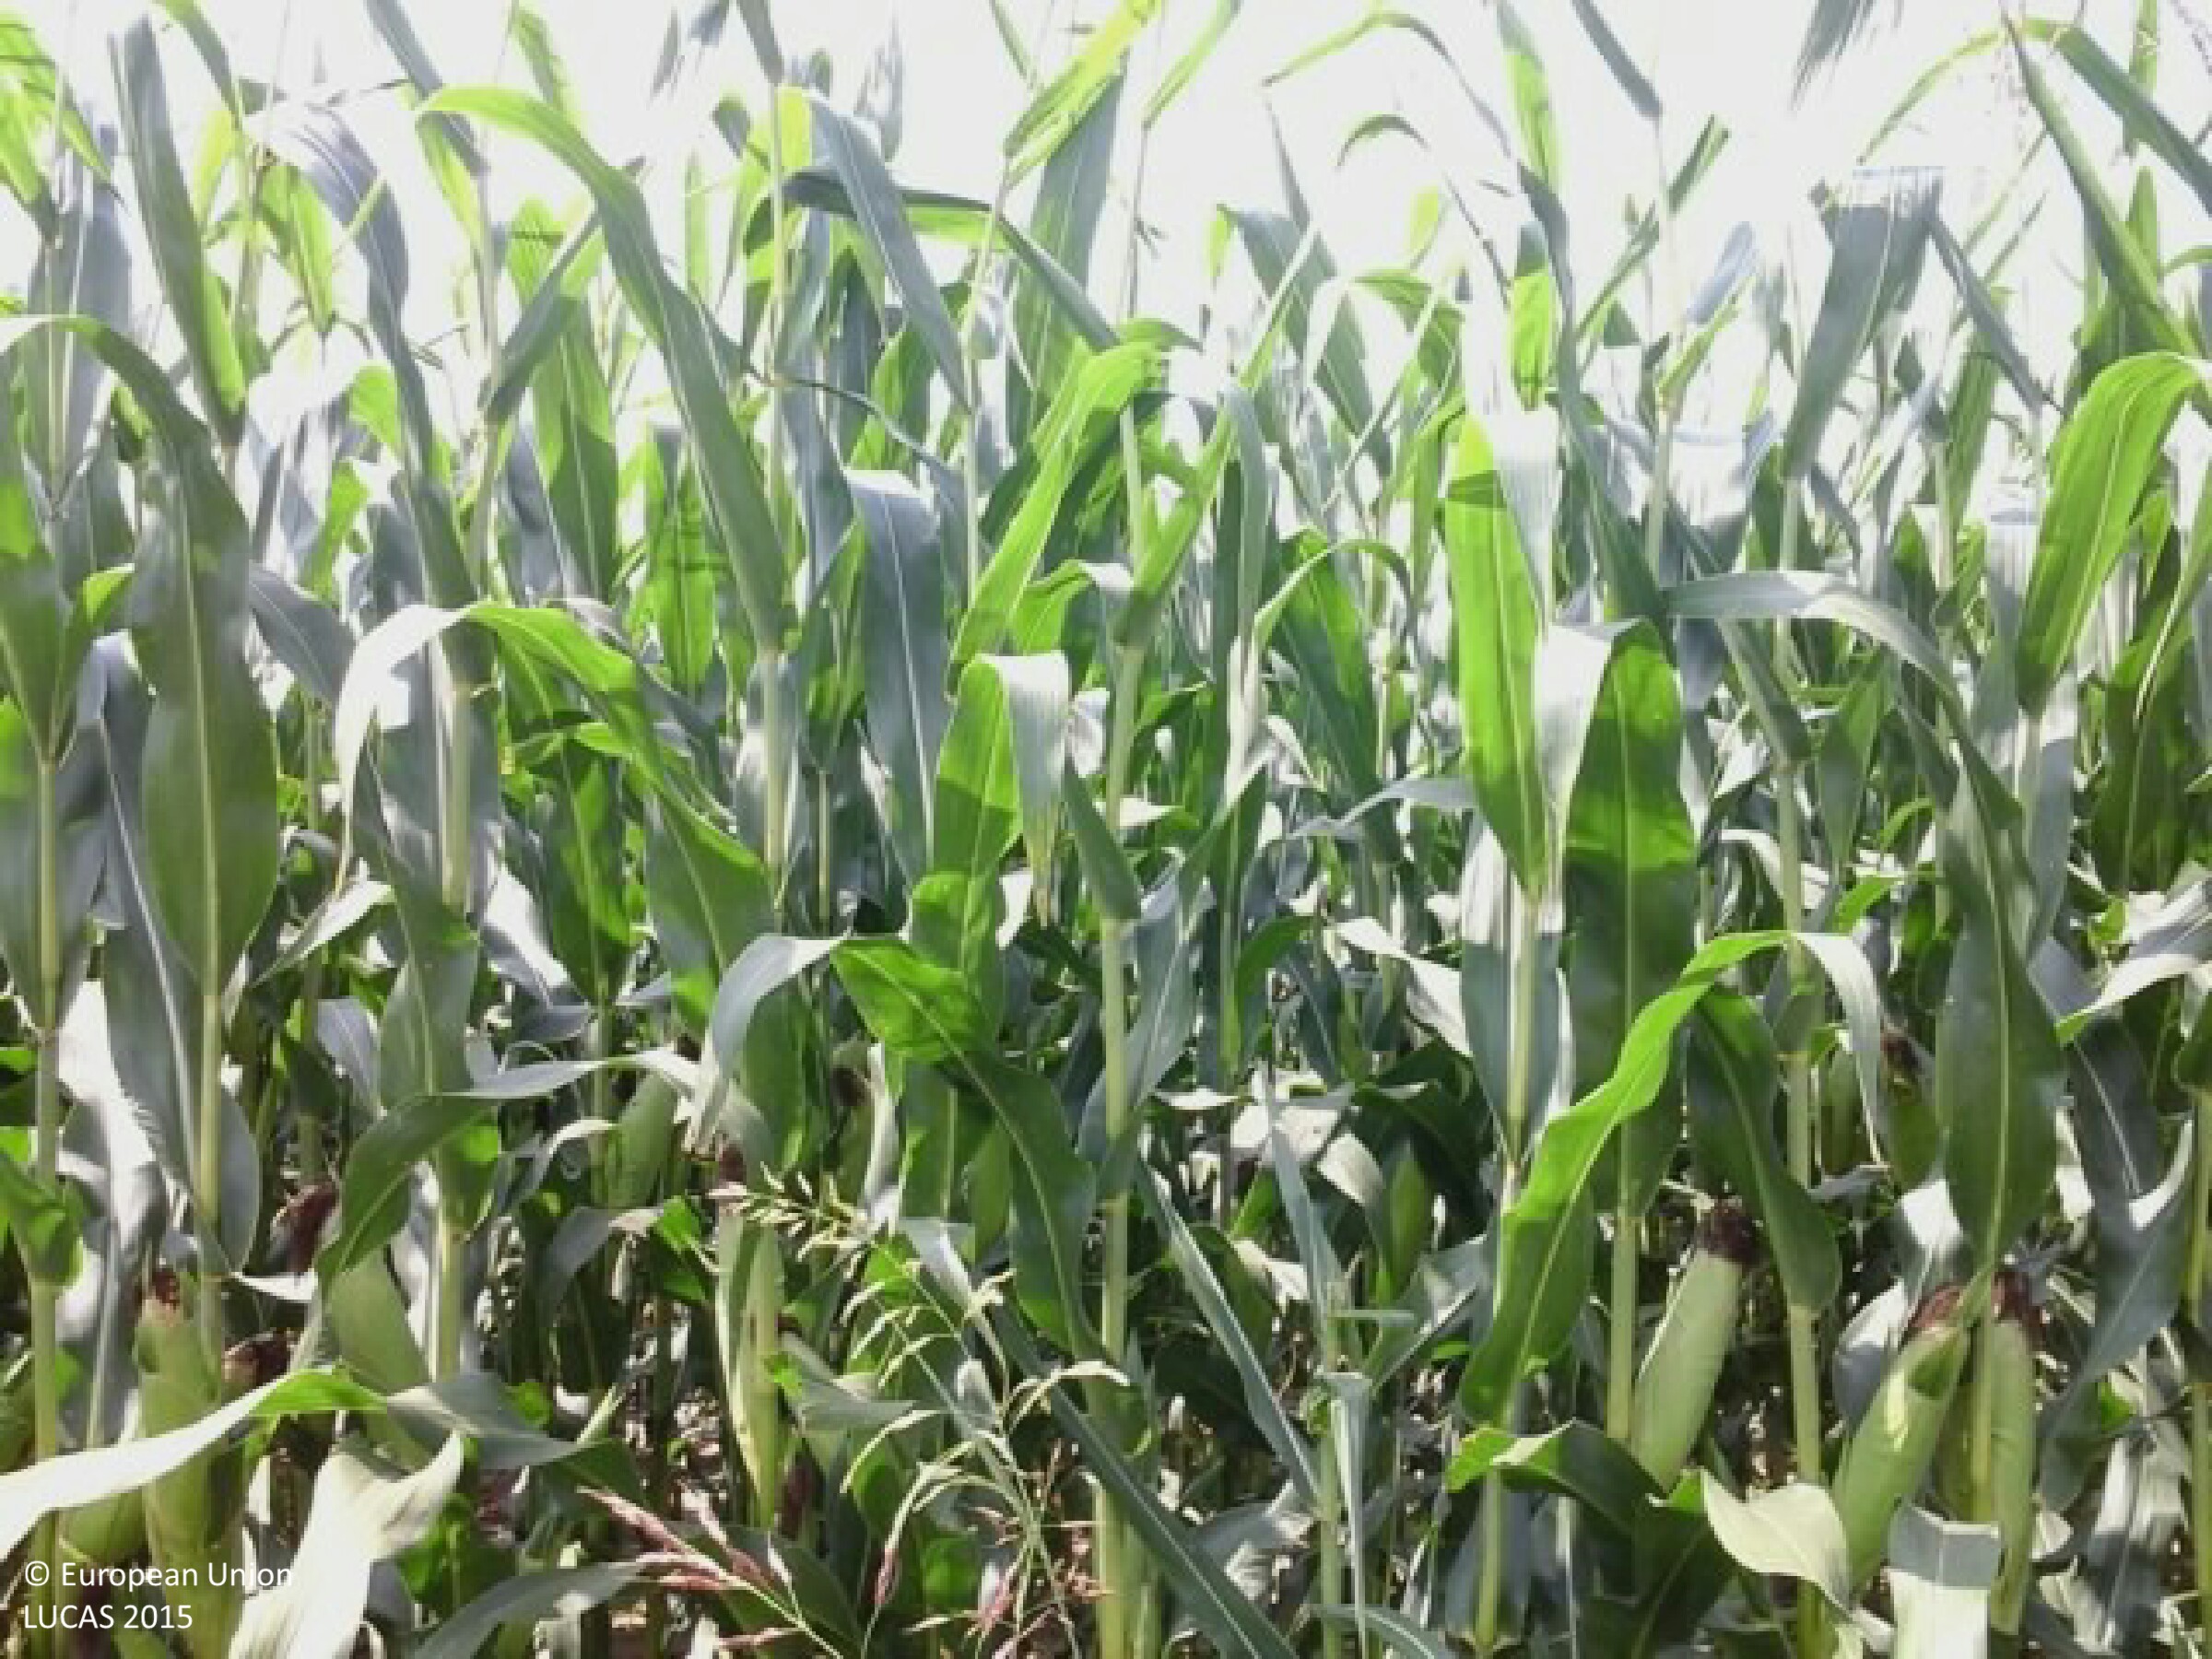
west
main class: Cropland
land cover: Maize
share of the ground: > 75 %
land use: Agriculture (excluding fallow land and kitchen gardens)
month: August
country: HU
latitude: 46.3448
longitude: 17.9455
